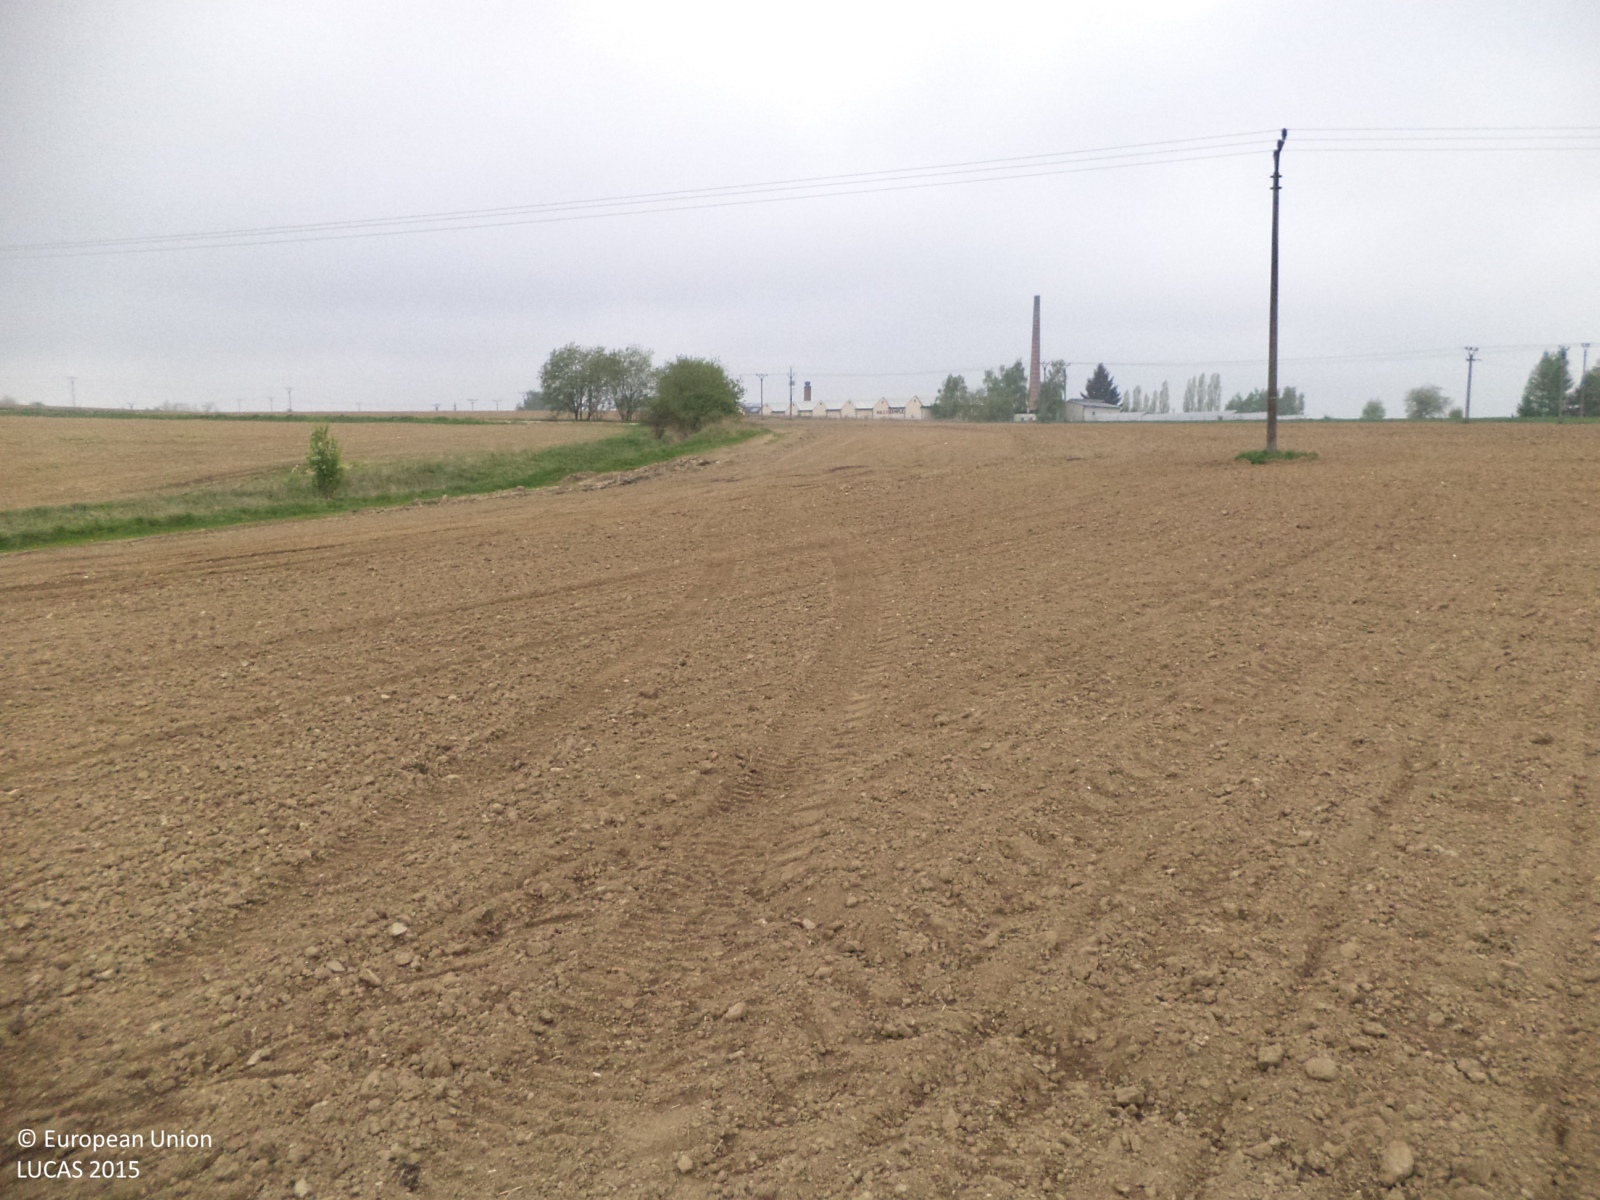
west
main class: Cropland
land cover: Maize
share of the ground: < 10 %
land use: Agriculture (excluding fallow land and kitchen gardens)
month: May
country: CZ
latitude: 49.1873
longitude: 15.4779
